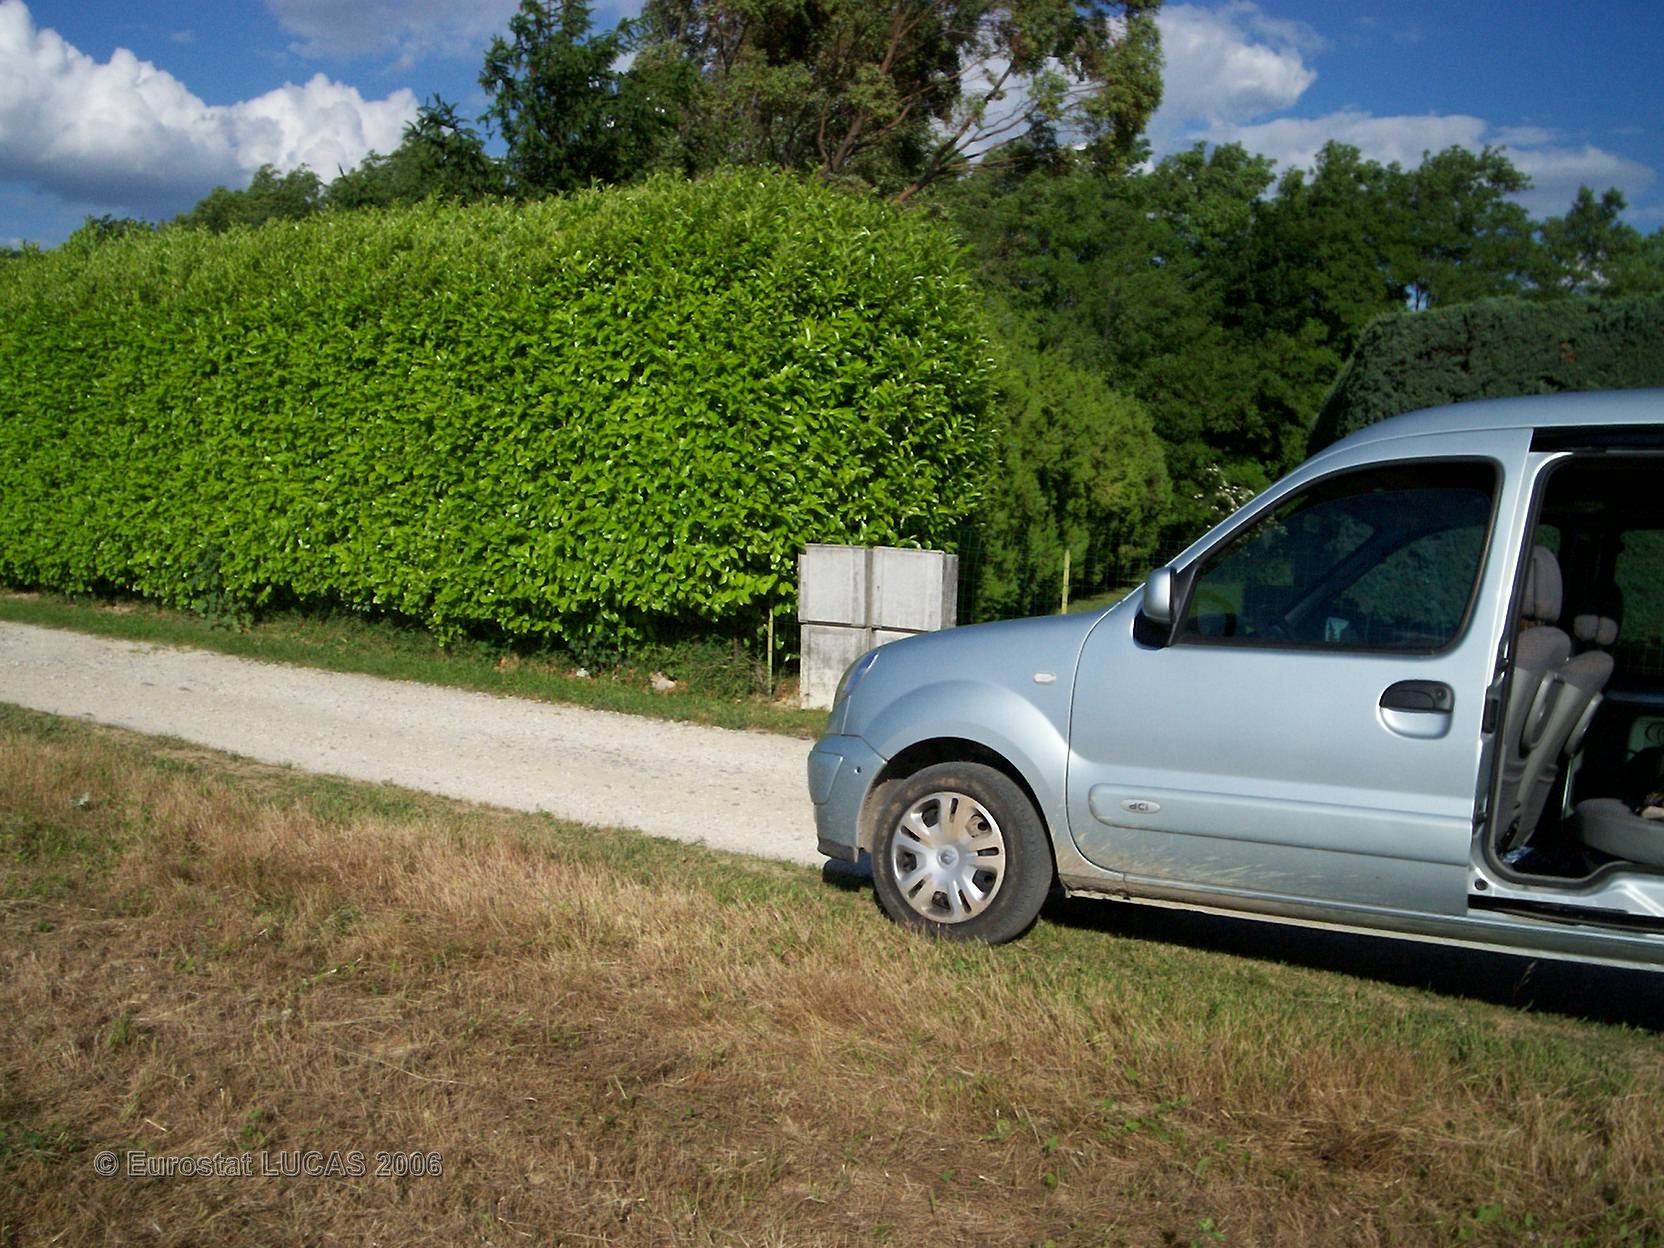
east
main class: Grassland
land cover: Grassland without tree/shrub cover
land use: Agriculture (excluding fallow land and kitchen gardens)
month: May
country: FR
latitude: 44.7269
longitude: 4.8169
